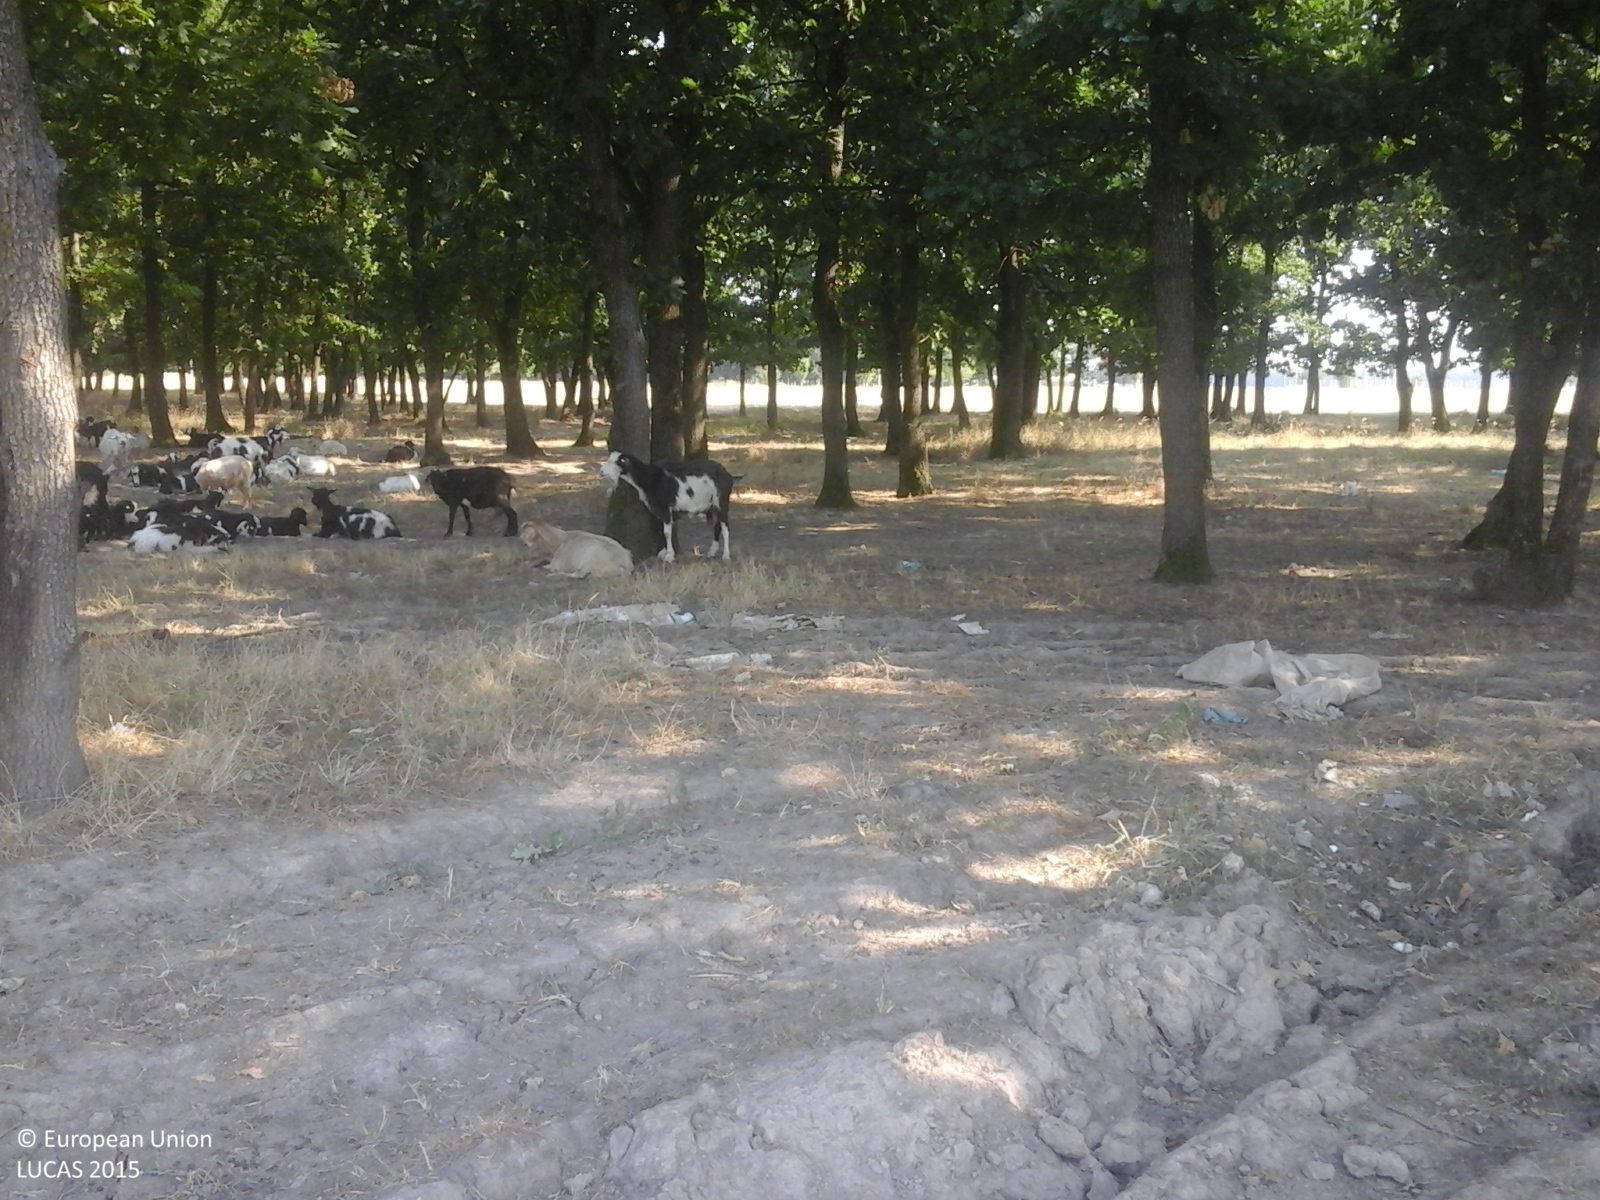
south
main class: Woodland
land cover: Broadleaved woodland
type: acidophilous oak and oak-birch forest
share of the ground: > 75 %
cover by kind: broadleaved forest trees 100 %
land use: Forestry
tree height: > 5 m
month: August
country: RO
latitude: 44.2743
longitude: 23.7240
